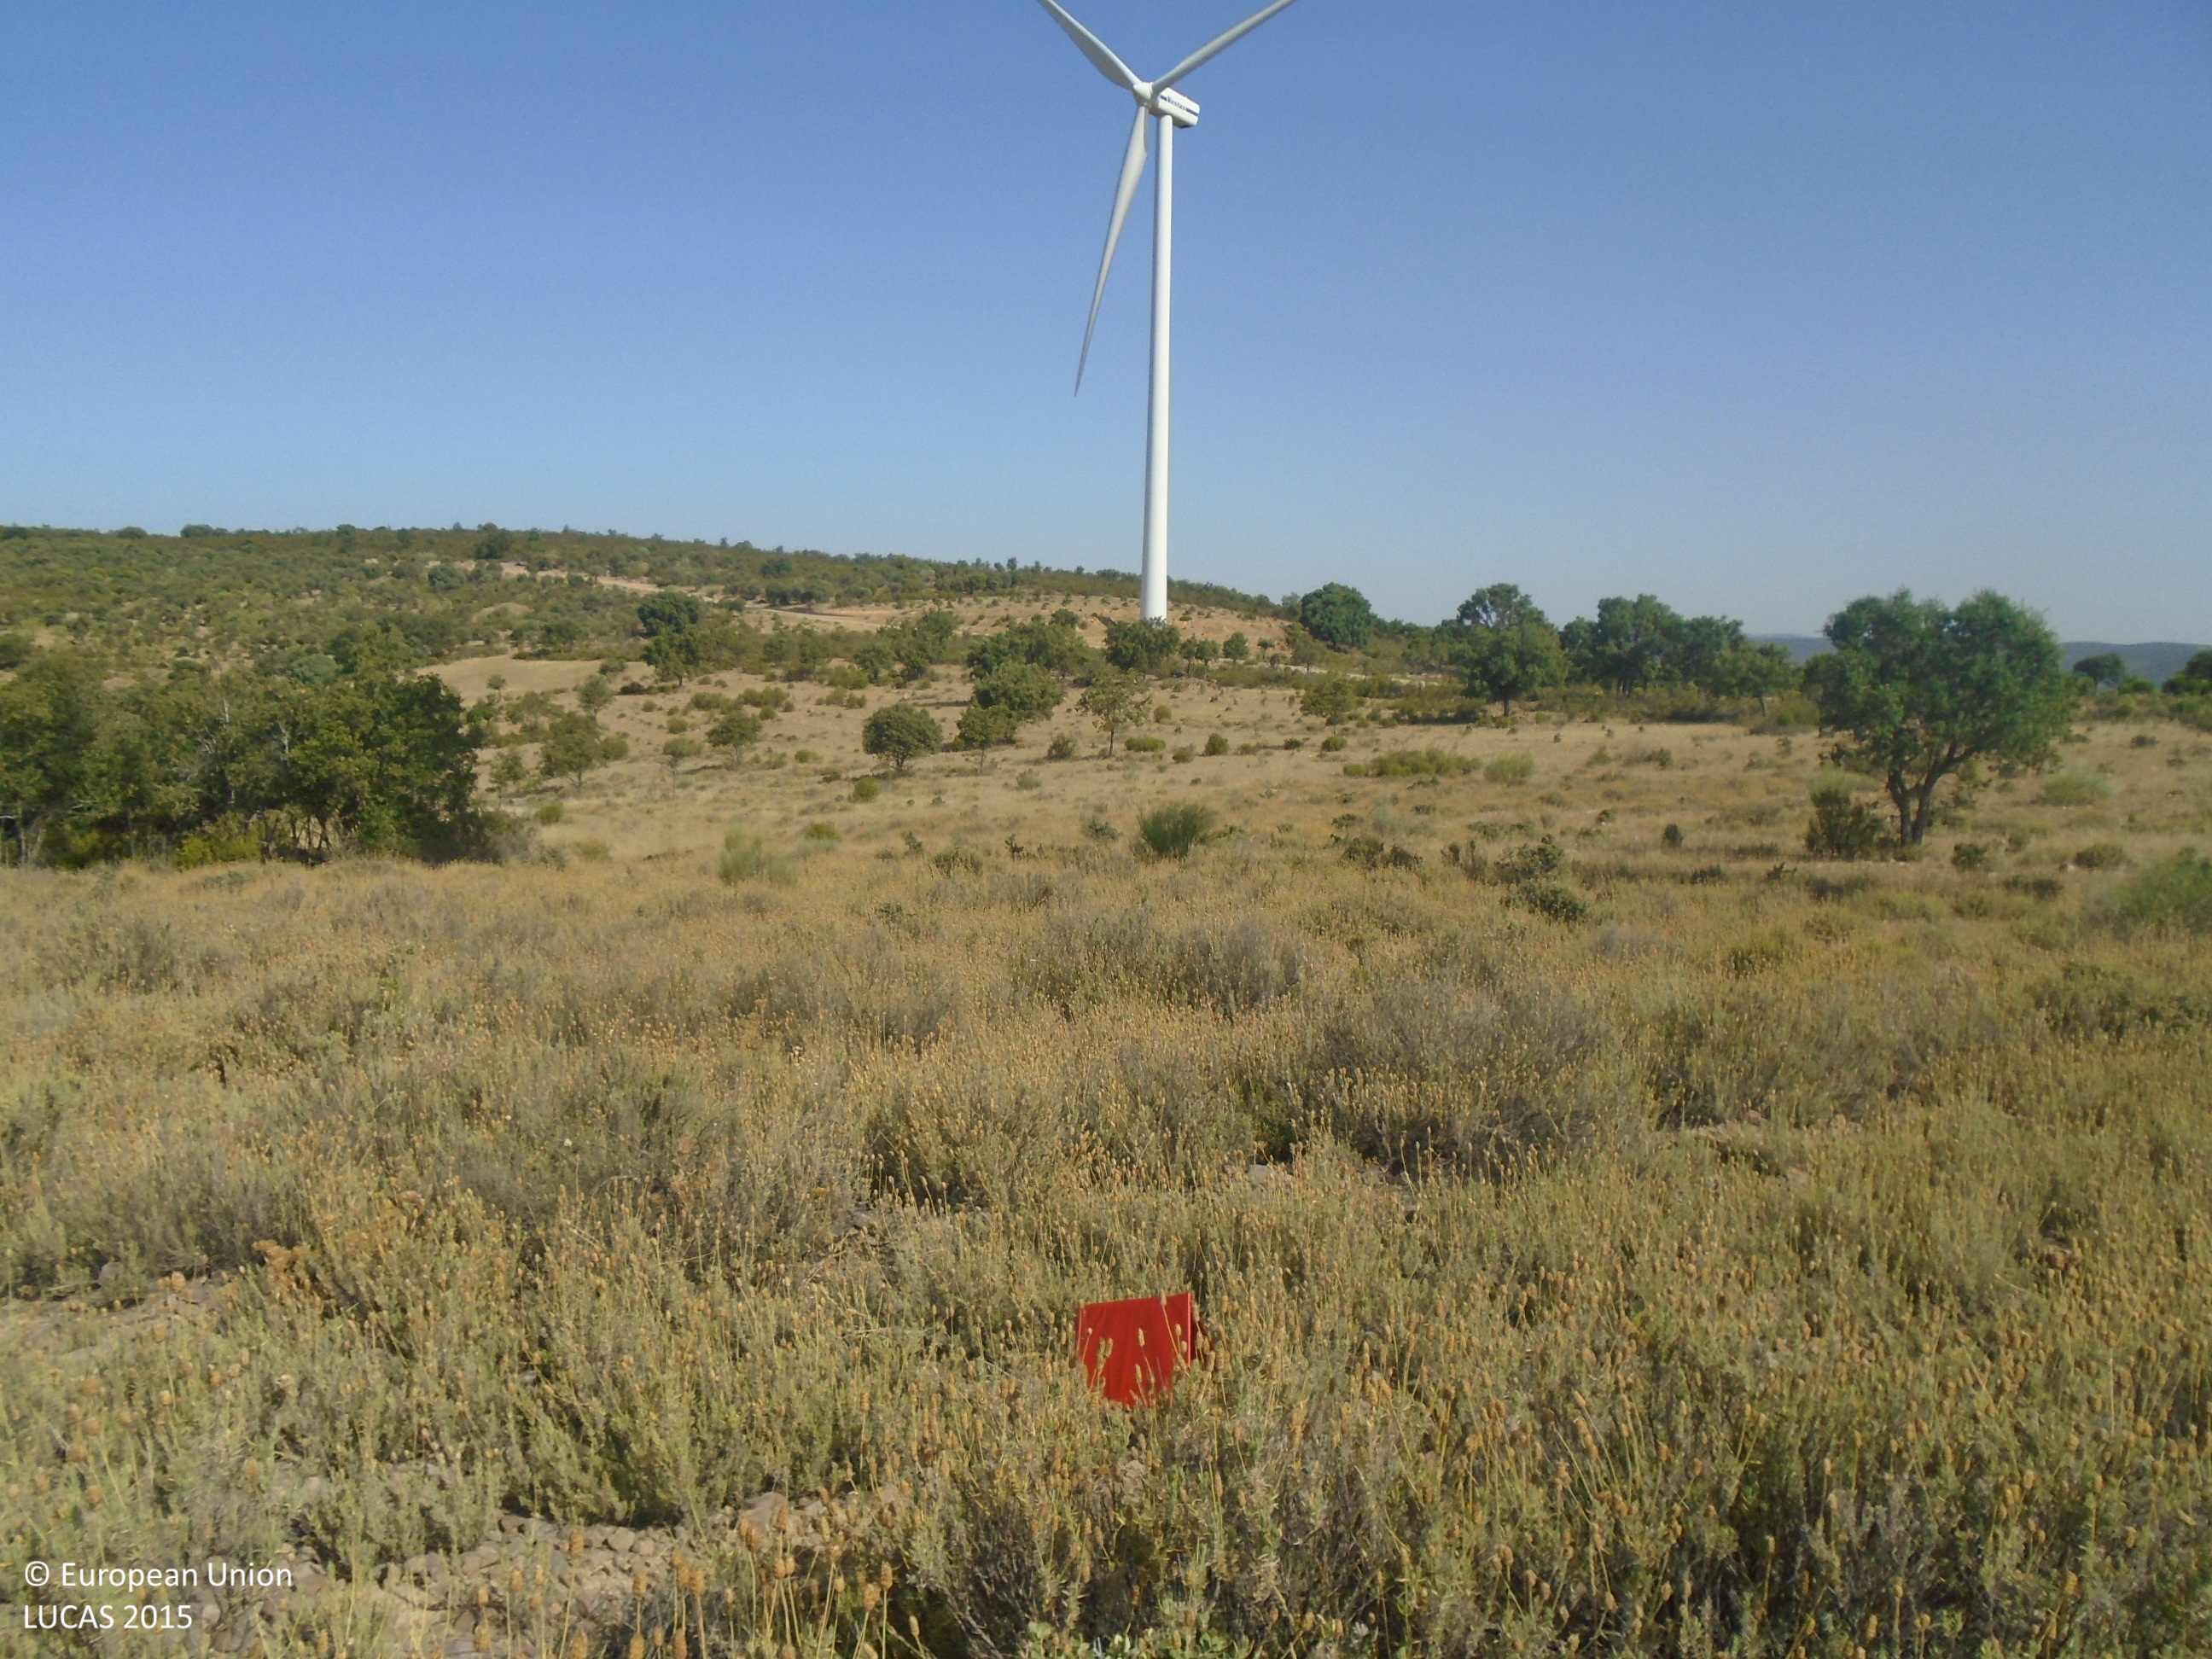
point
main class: Shrubland
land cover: Shrubland without tree cover
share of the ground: > 75 %
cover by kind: shrubs 100 %
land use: Agriculture (excluding fallow land and kitchen gardens)
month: July
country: ES
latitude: 39.2850
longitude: -4.0662
